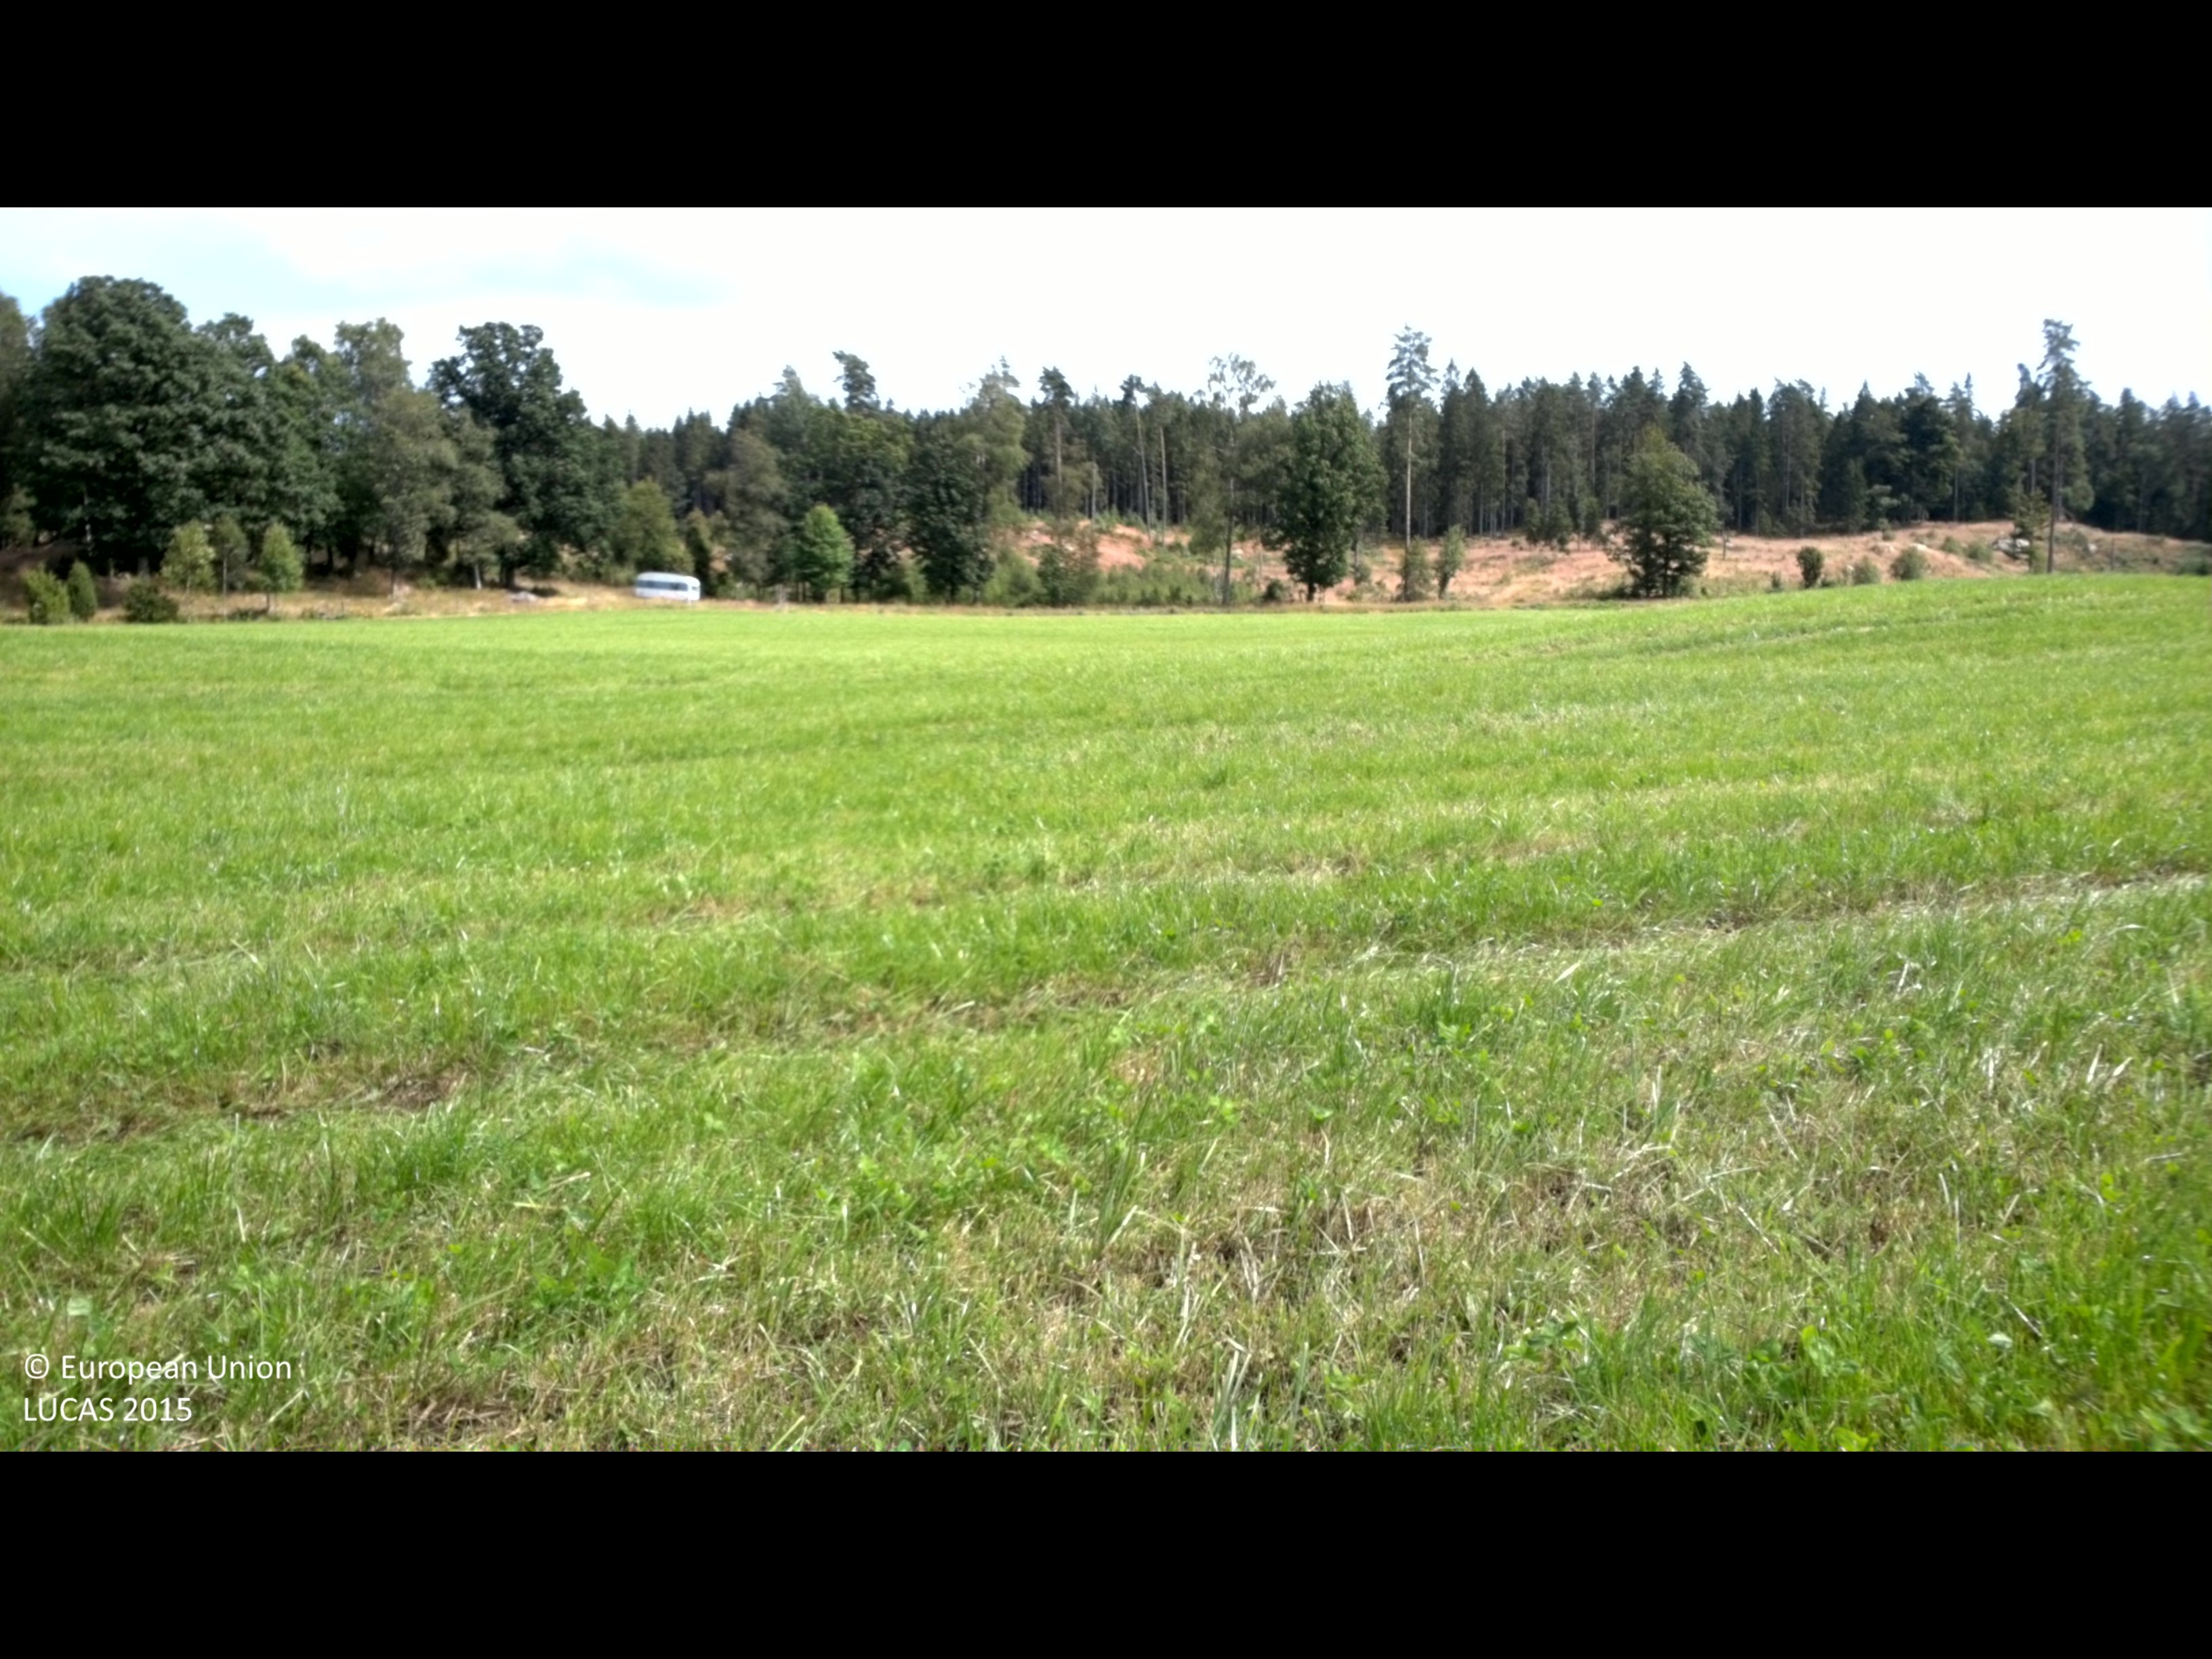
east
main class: Cropland
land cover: Temporary grasslands
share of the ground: > 75 %
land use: Agriculture (excluding fallow land and kitchen gardens)
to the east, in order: Grass margins; Temporary grasslands; Fences; Grassland with sparse tree/shrub cover; Fences; Broadleaved woodland; Shrubland without tree cover; Spruce dominated mixed woodland
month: August
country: SE
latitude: 56.3862
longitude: 14.2896
